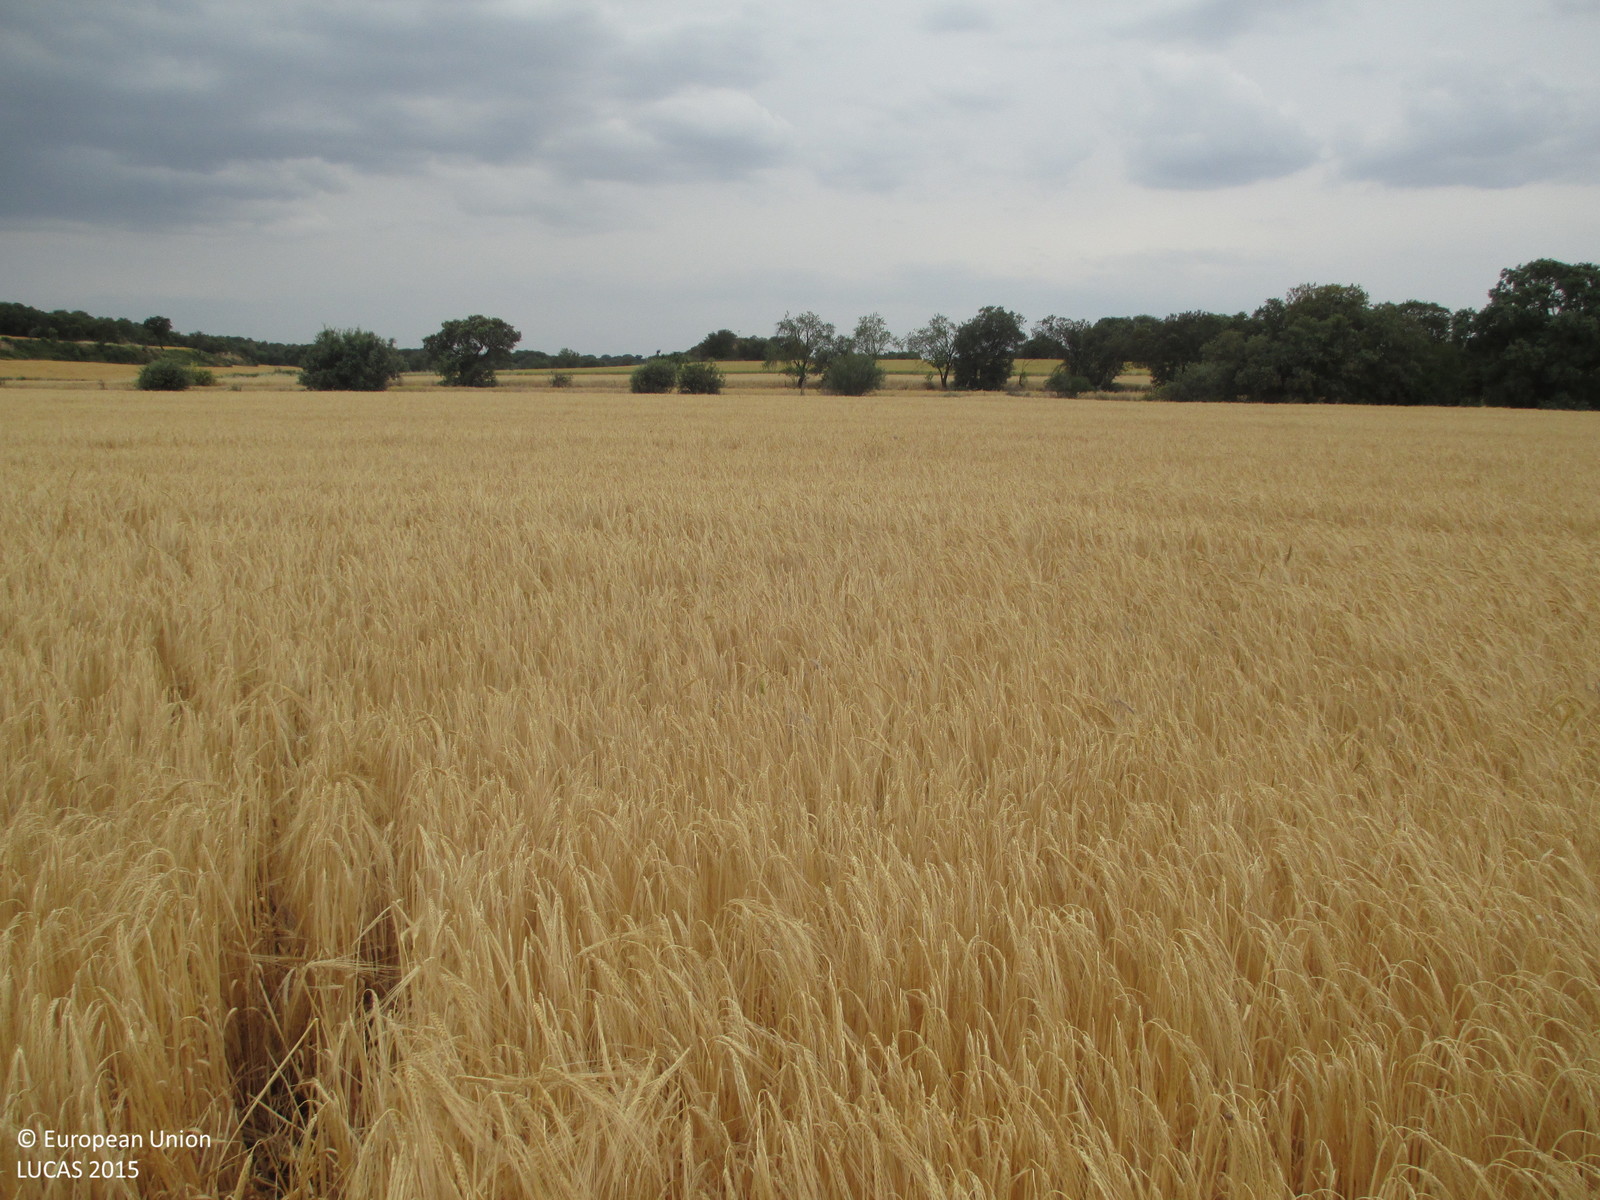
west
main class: Cropland
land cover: Barley
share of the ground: > 75 %
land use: Agriculture (excluding fallow land and kitchen gardens)
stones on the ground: < 10 %
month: May
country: ES
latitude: 42.1000
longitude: -0.2142
